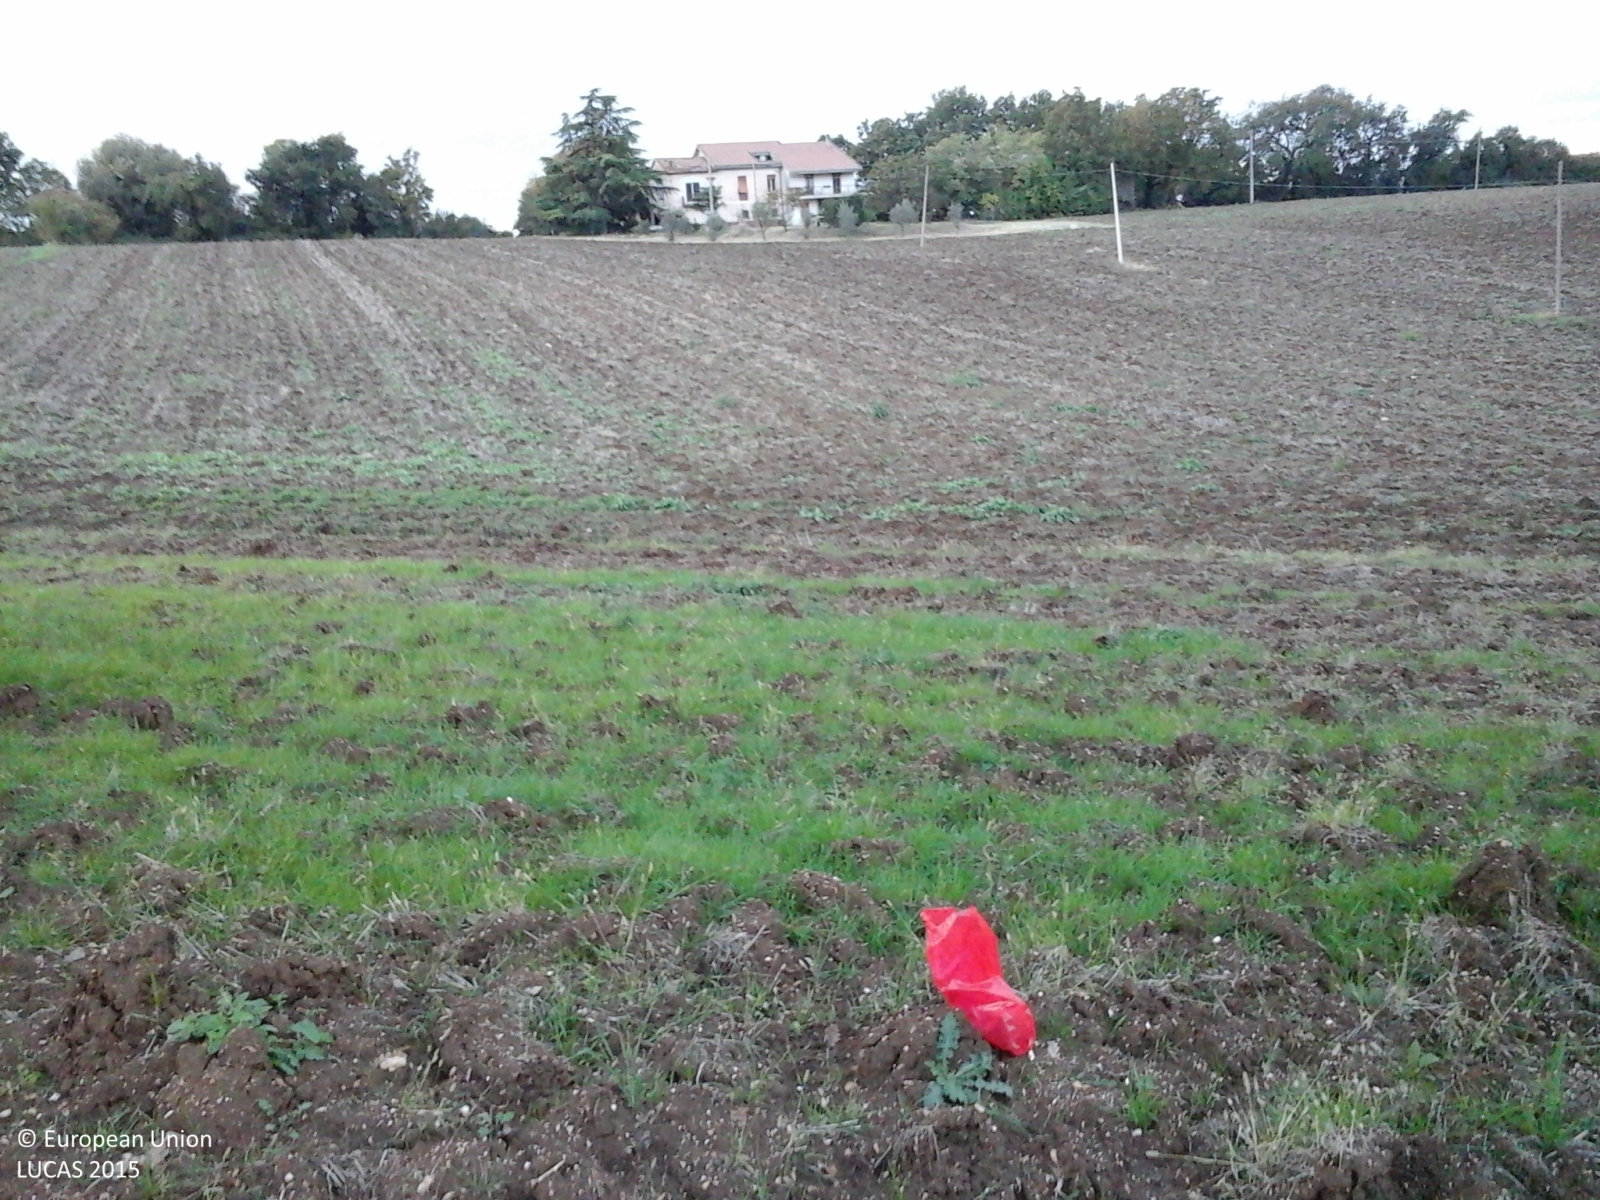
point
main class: Cropland
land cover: Common wheat
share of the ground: < 10 %
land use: Agriculture (excluding fallow land and kitchen gardens)
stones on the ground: < 10 %
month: October
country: IT
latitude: 42.6763
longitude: 12.5424
